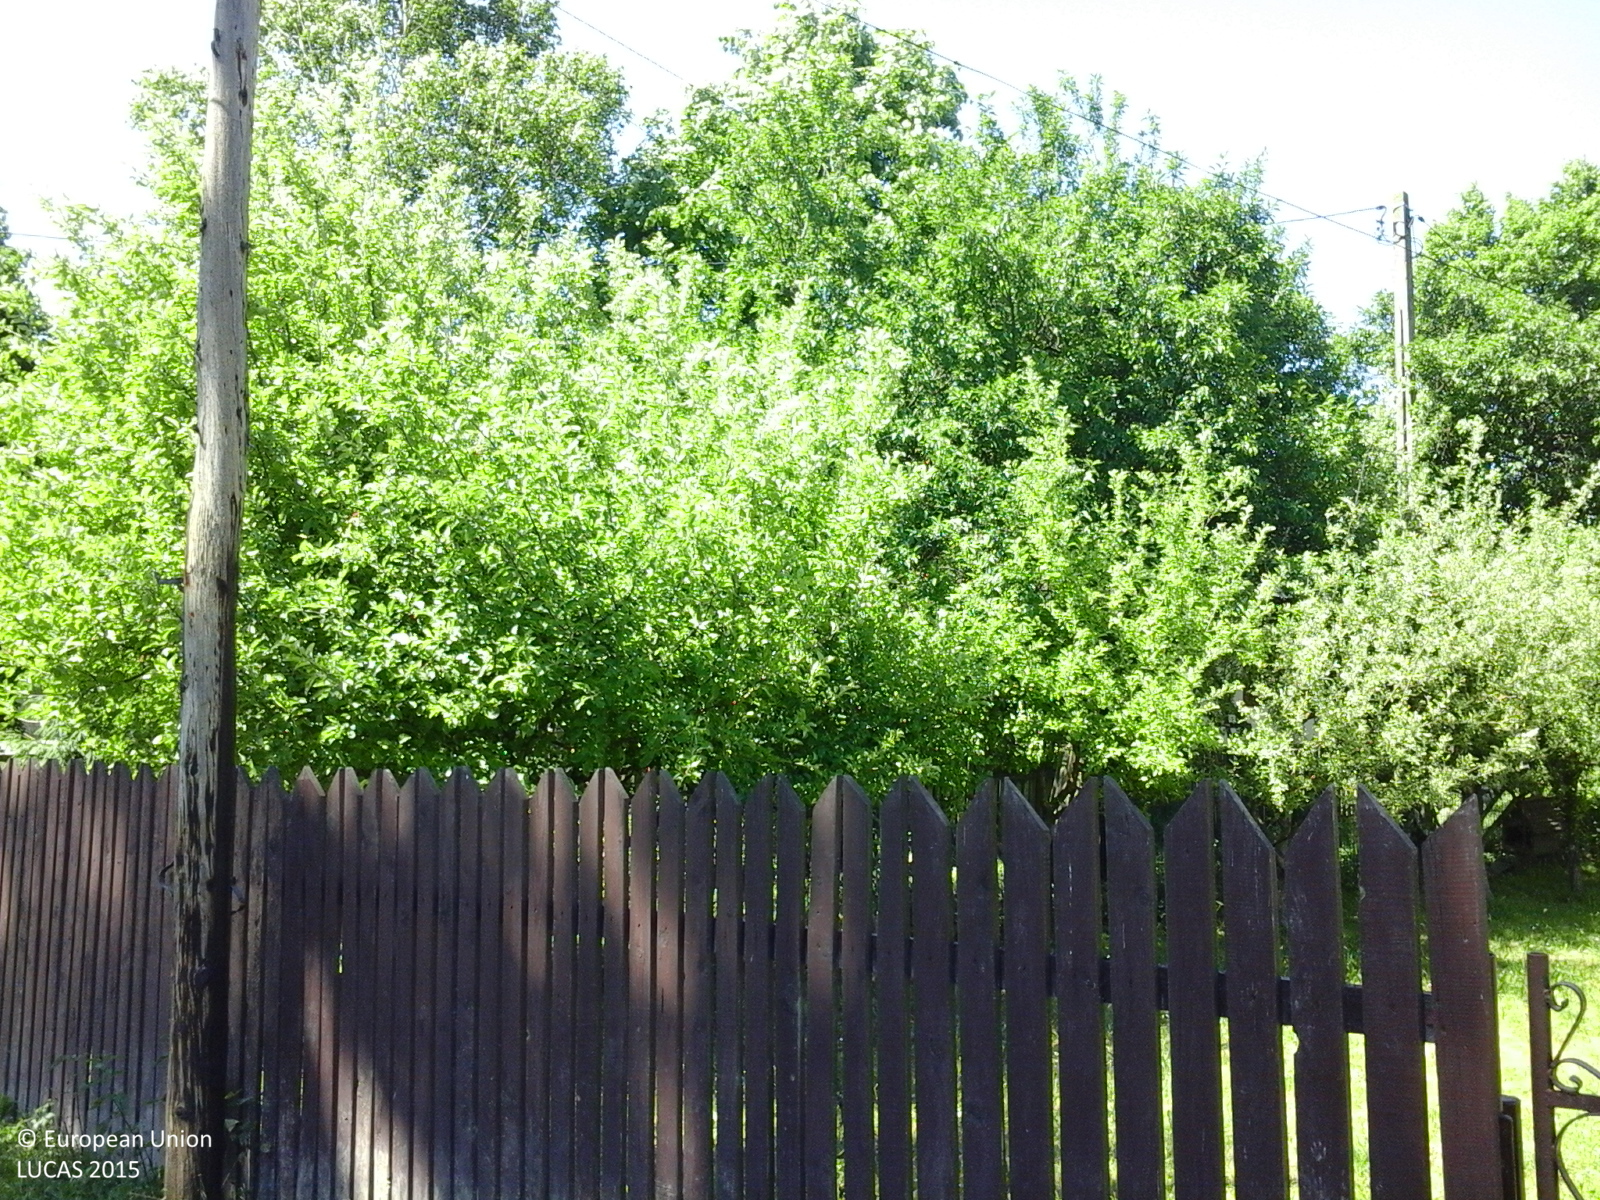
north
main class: Cropland
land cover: Apple fruit
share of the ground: 25 - 50 %
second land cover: Grassland without tree/shrub cover
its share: 50 - 75 %
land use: Agriculture (excluding fallow land and kitchen gardens)
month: June
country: RO
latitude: 45.3885
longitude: 25.1770
